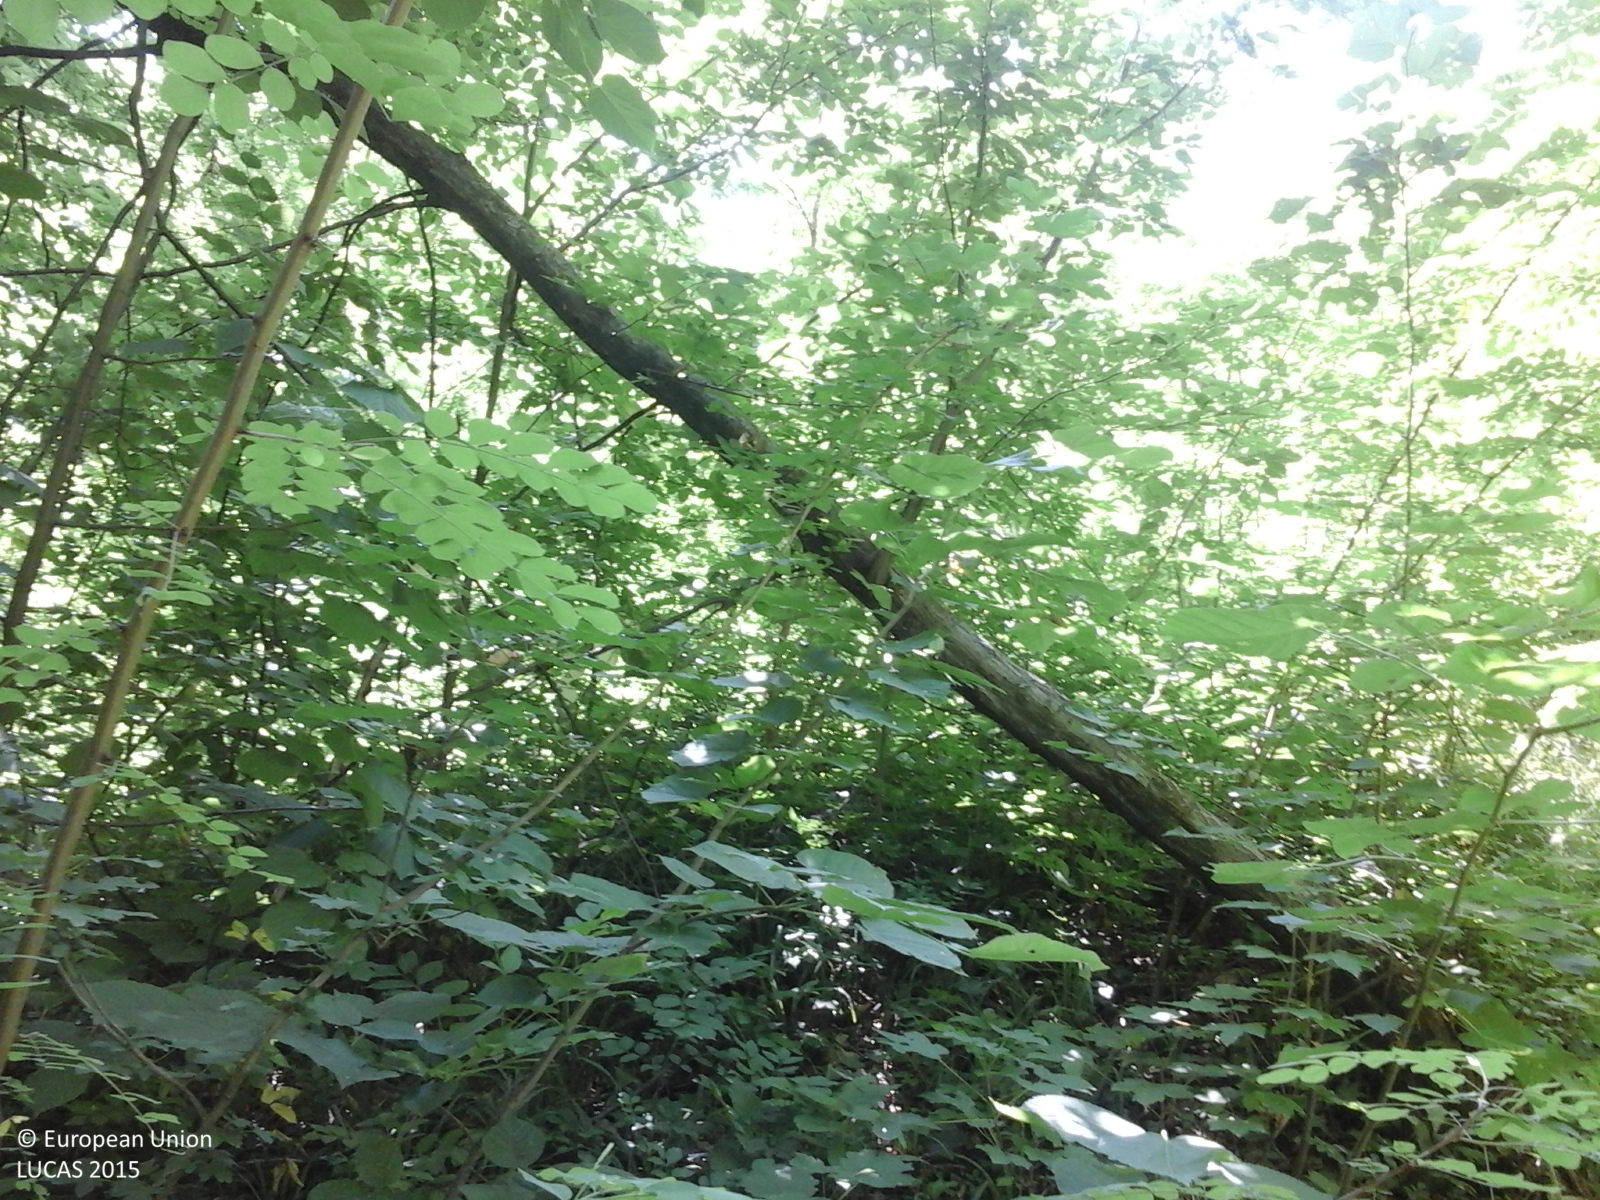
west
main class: Woodland
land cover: Broadleaved woodland
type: mesophytic deciduous forest
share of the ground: > 75 %
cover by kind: broadleaved forest trees 100 %
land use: Forestry
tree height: > 5 m
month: June
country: RO
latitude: 47.0176
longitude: 27.5743
